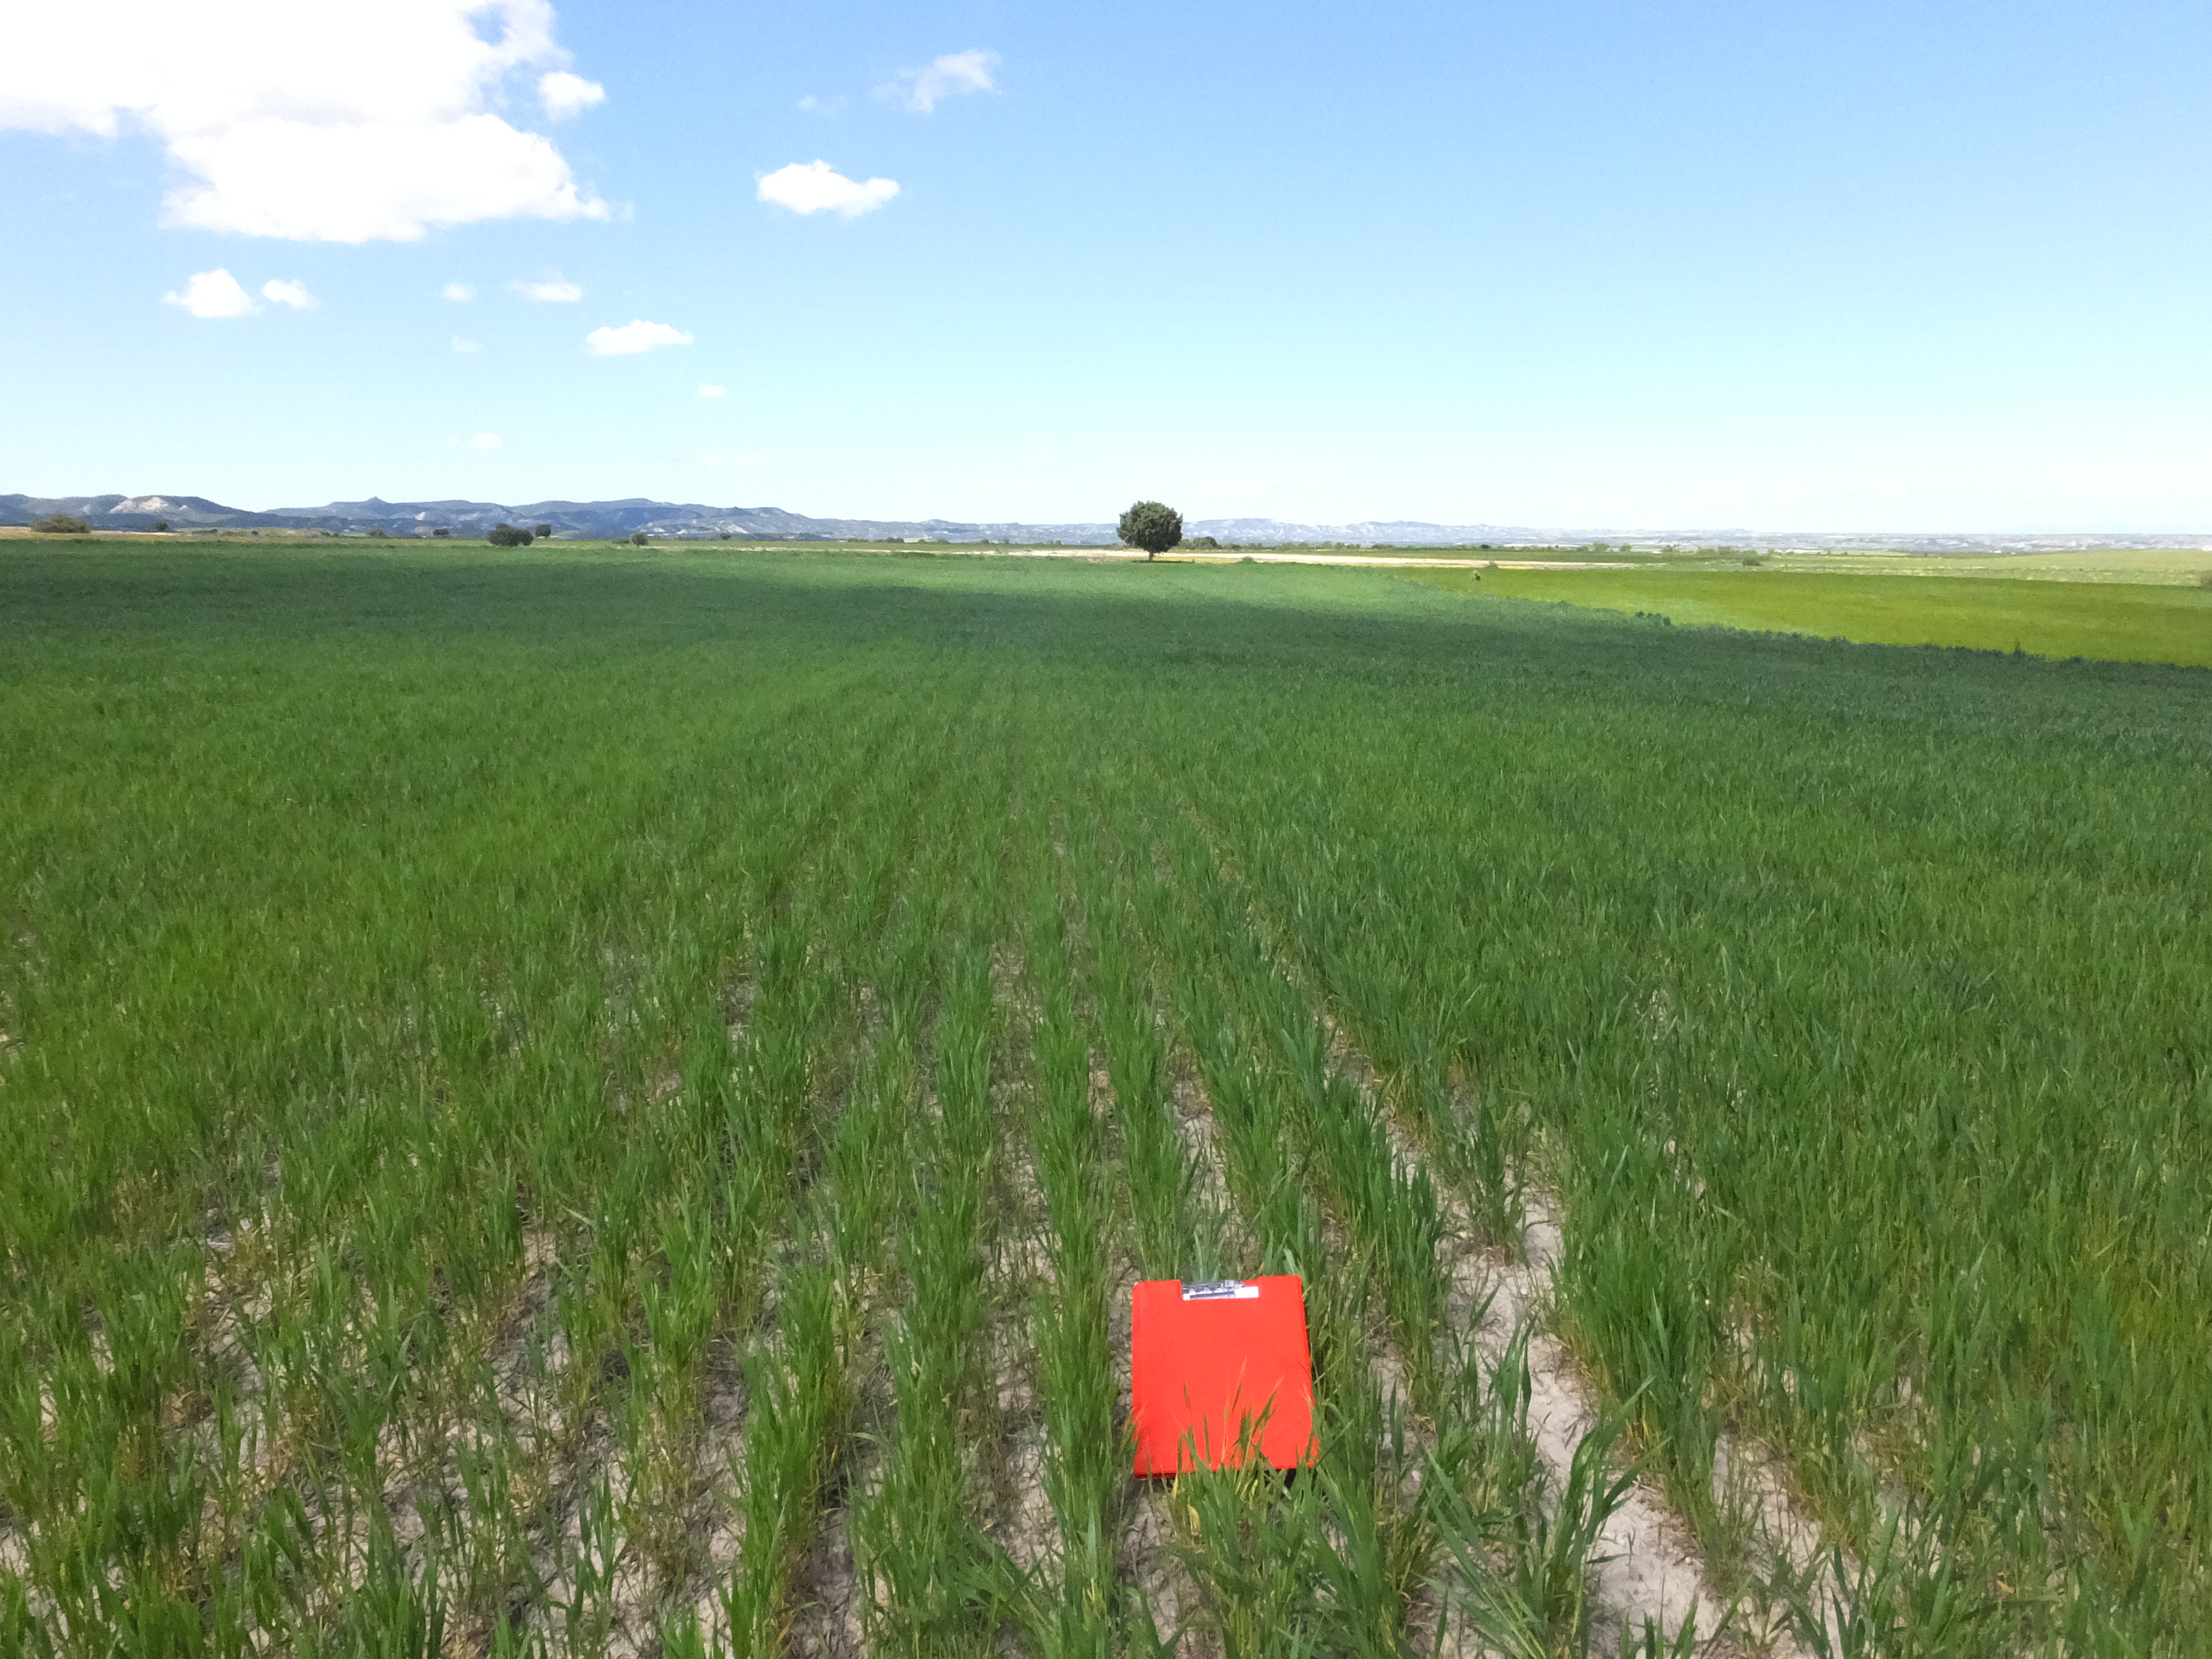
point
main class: Cropland
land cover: Barley
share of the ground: > 75 %
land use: Agriculture (excluding fallow land and kitchen gardens)
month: April
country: ES
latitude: 41.7072
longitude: -0.3176
